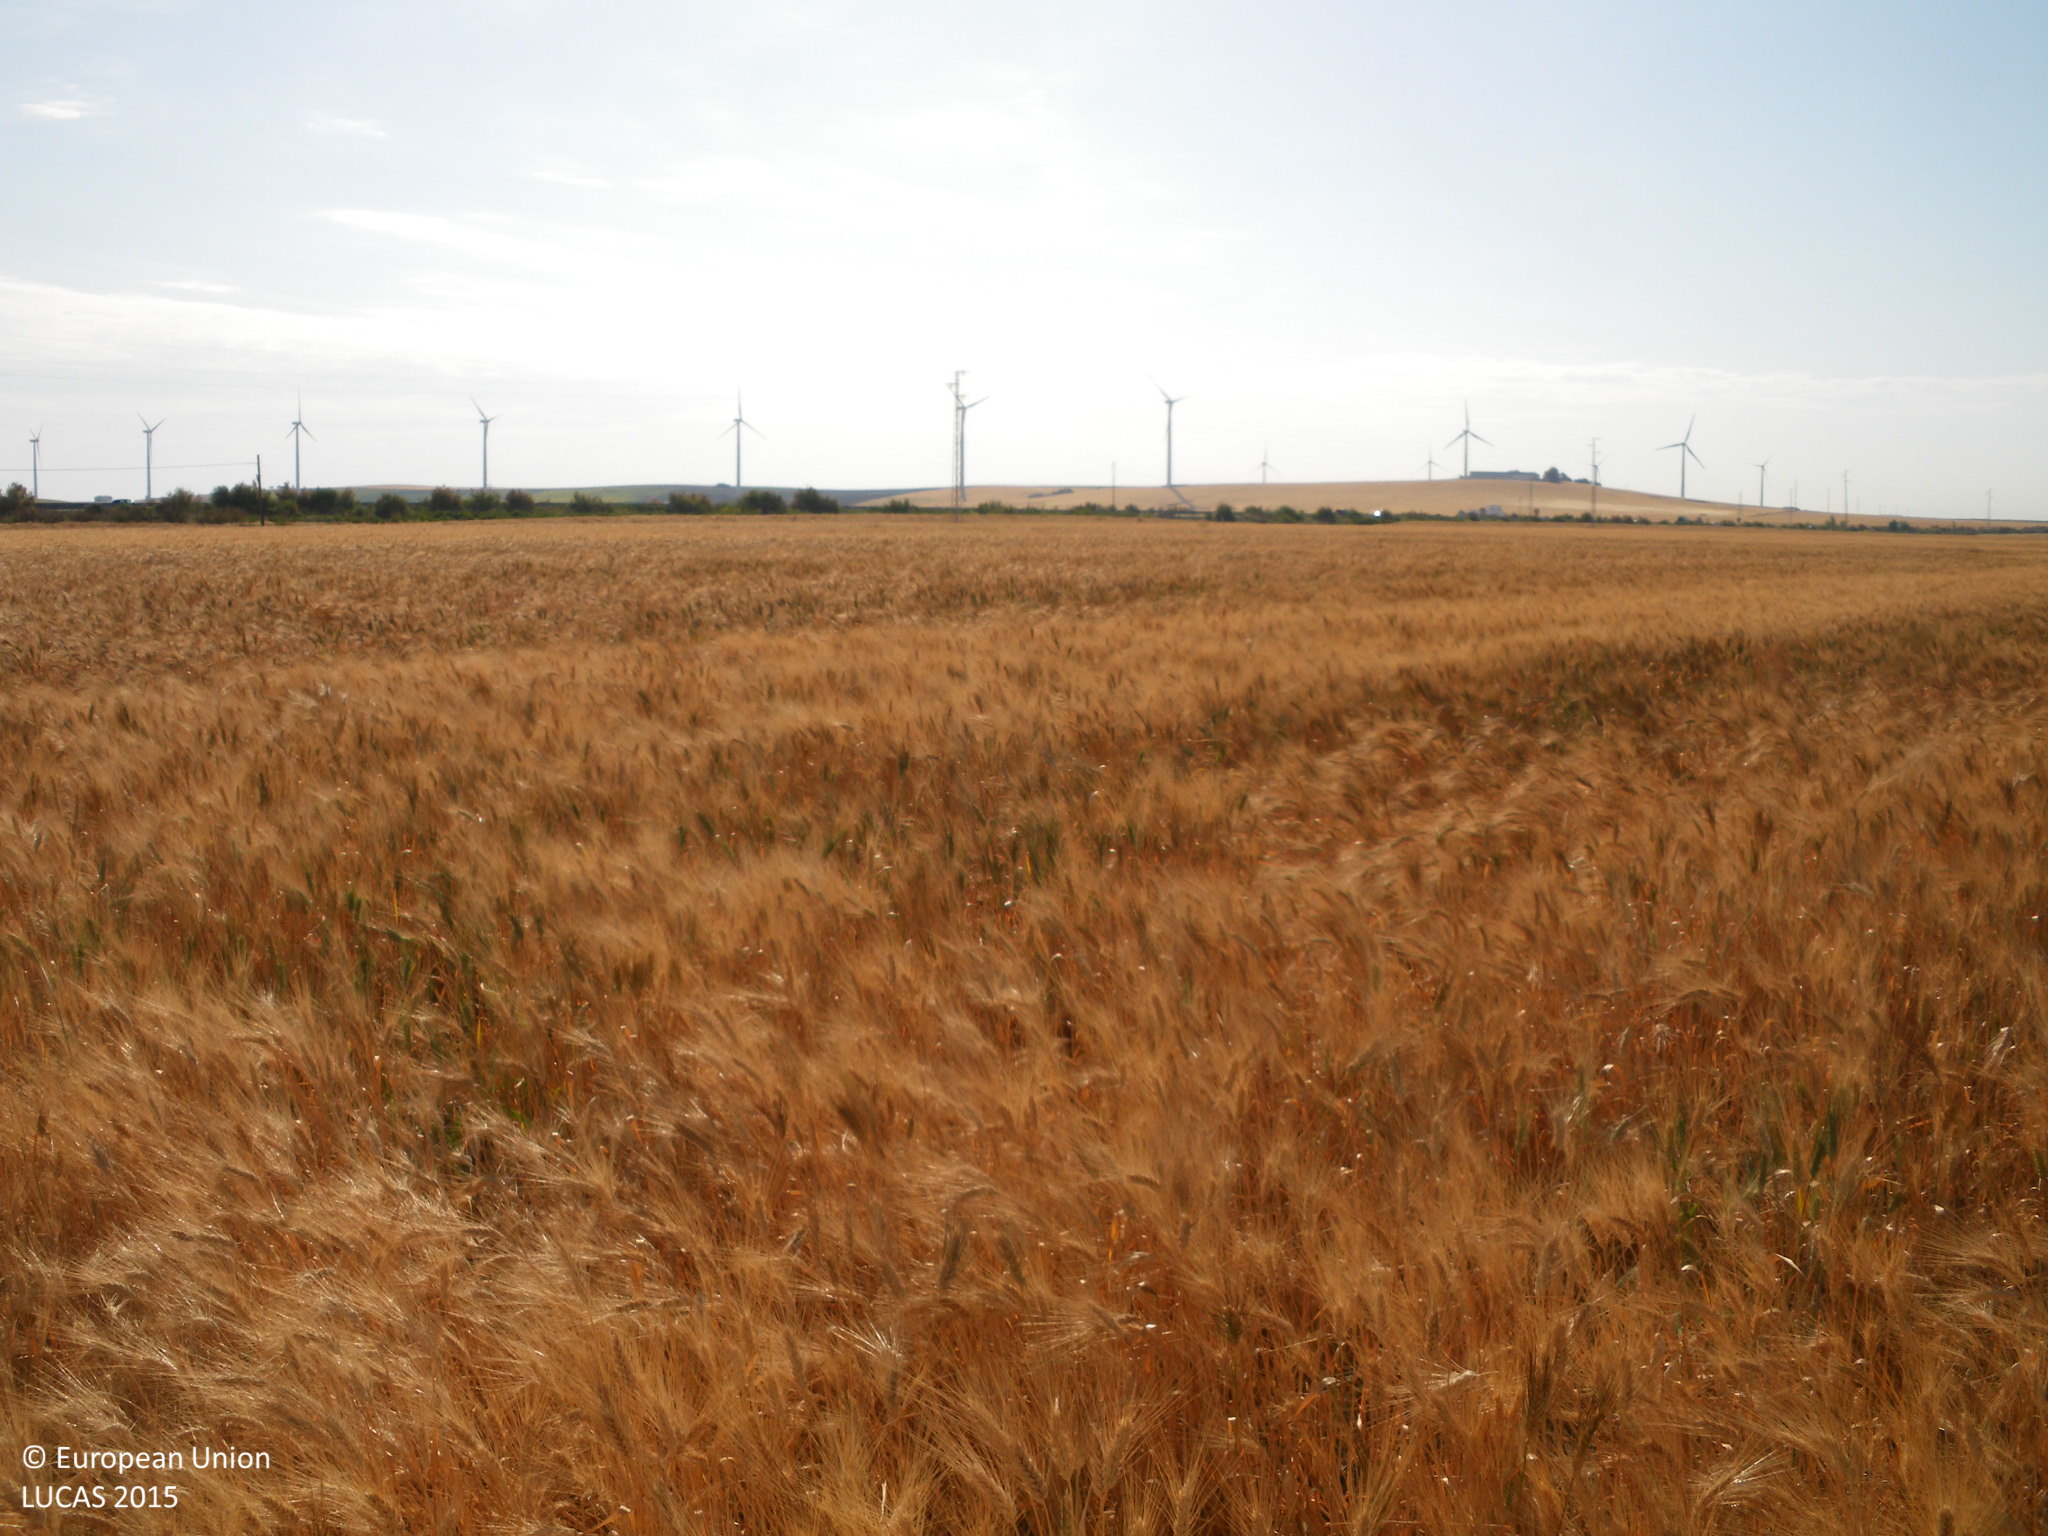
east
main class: Cropland
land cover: Durum wheat
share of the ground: > 75 %
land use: Agriculture (excluding fallow land and kitchen gardens)
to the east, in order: Durum wheat
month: May
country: ES
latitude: 36.7352
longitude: -6.3096
